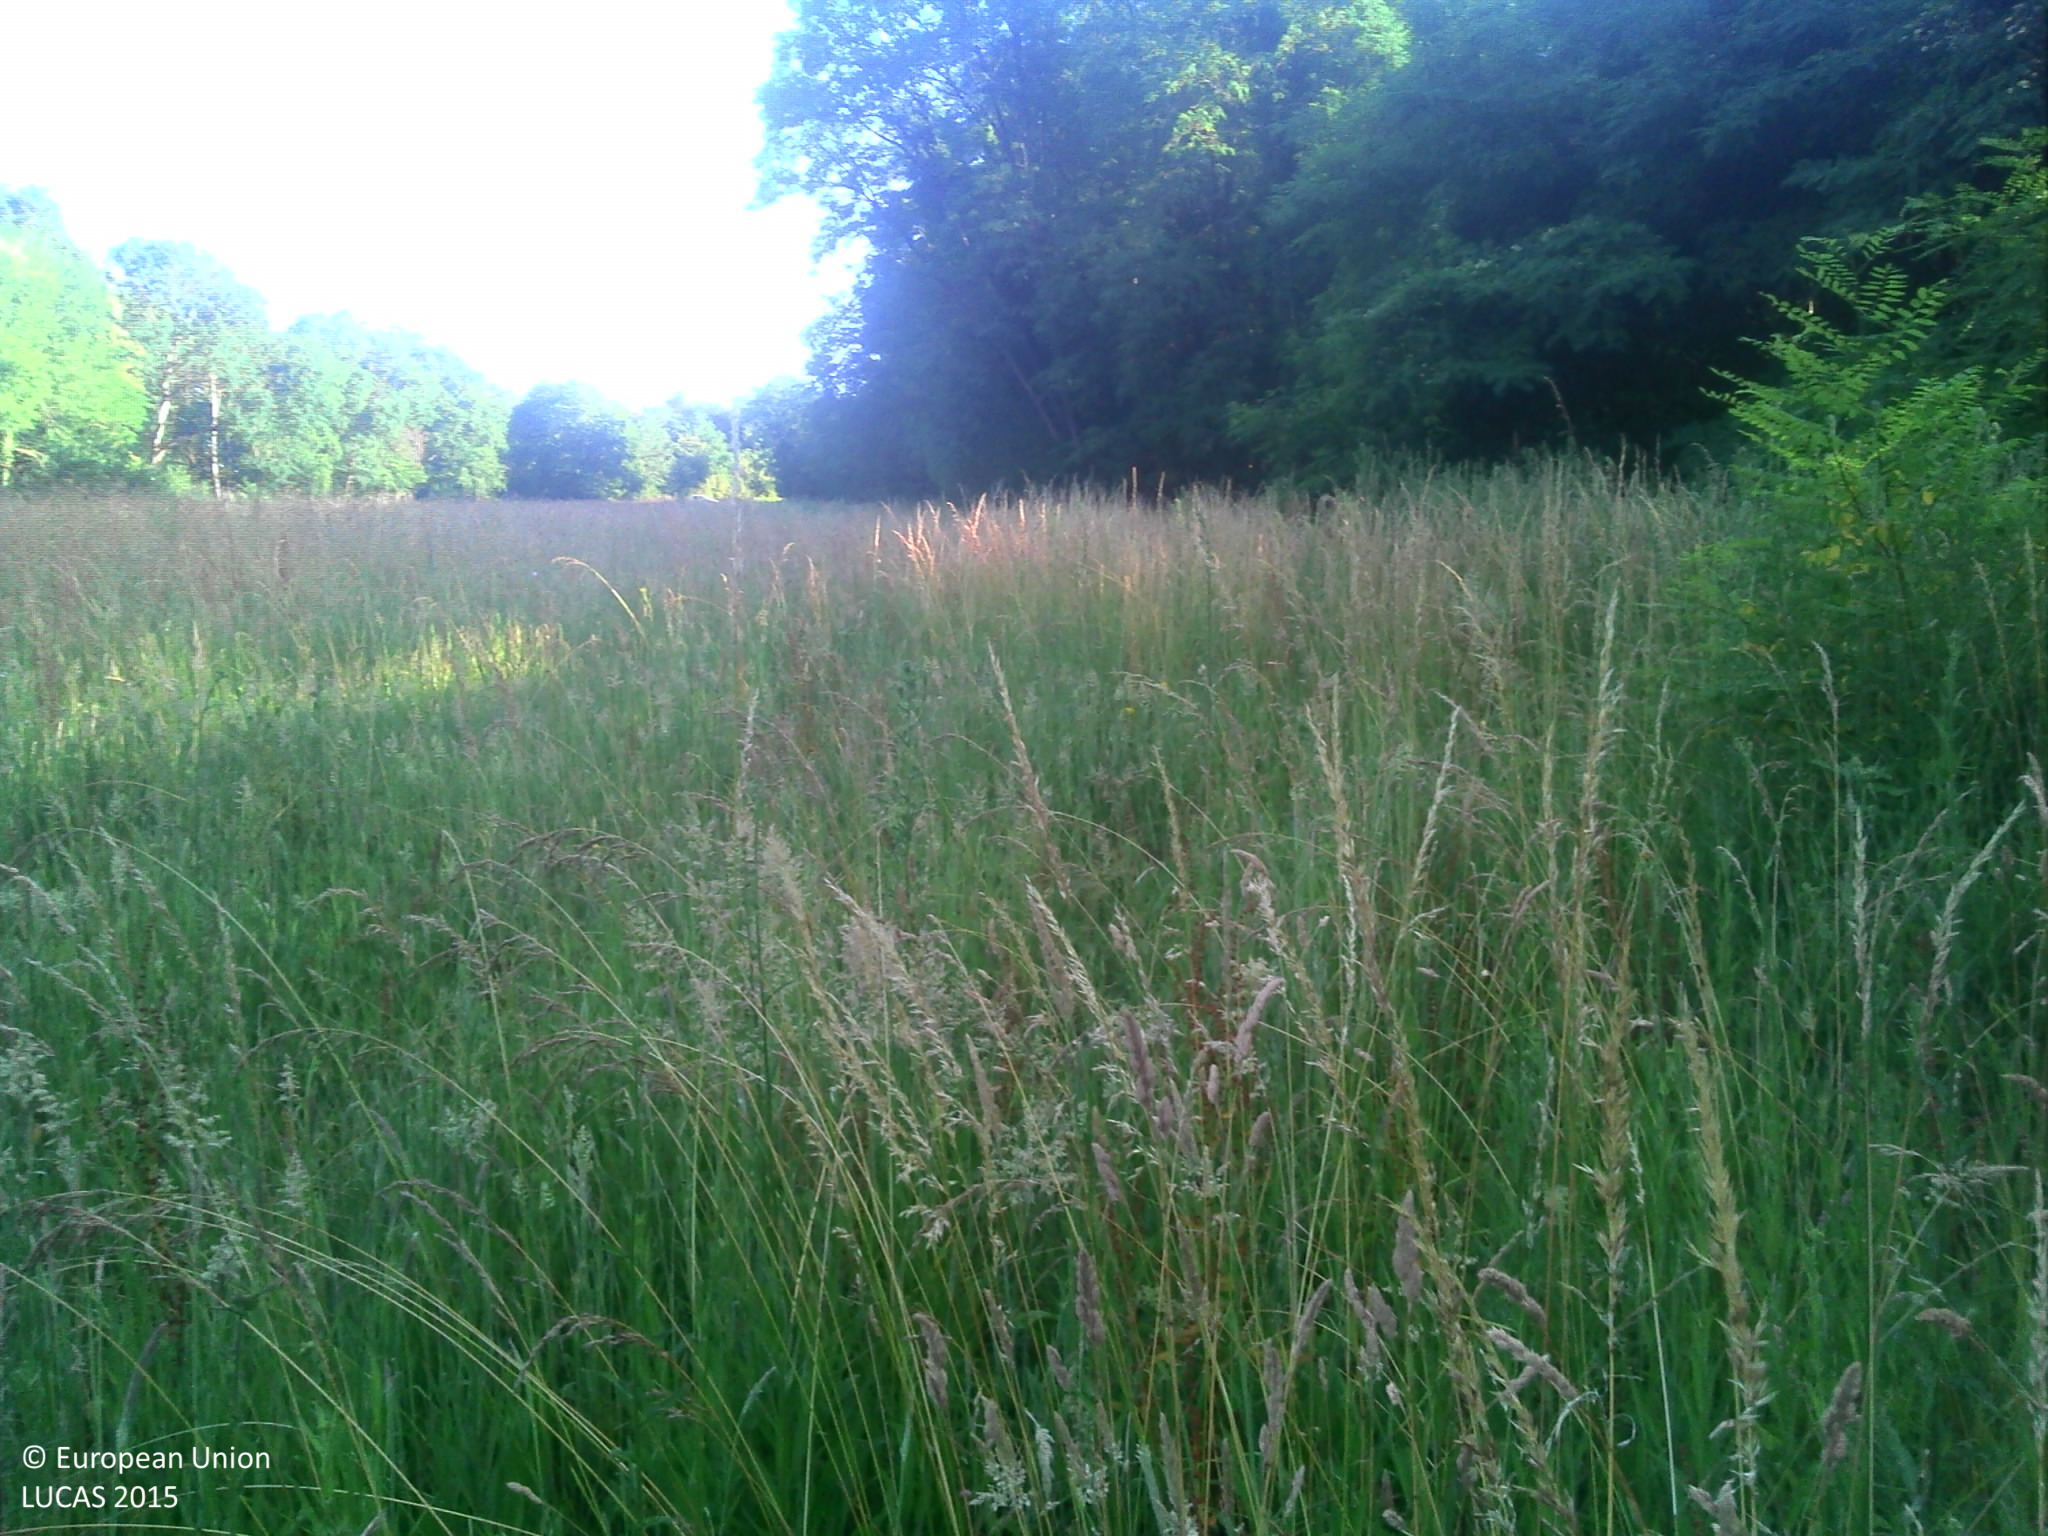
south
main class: Grassland
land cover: Grassland without tree/shrub cover
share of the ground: > 75 %
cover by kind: herbaceous plants 100 %
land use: Agriculture (excluding fallow land and kitchen gardens)
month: June
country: FR
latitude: 47.2386
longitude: 1.4398
